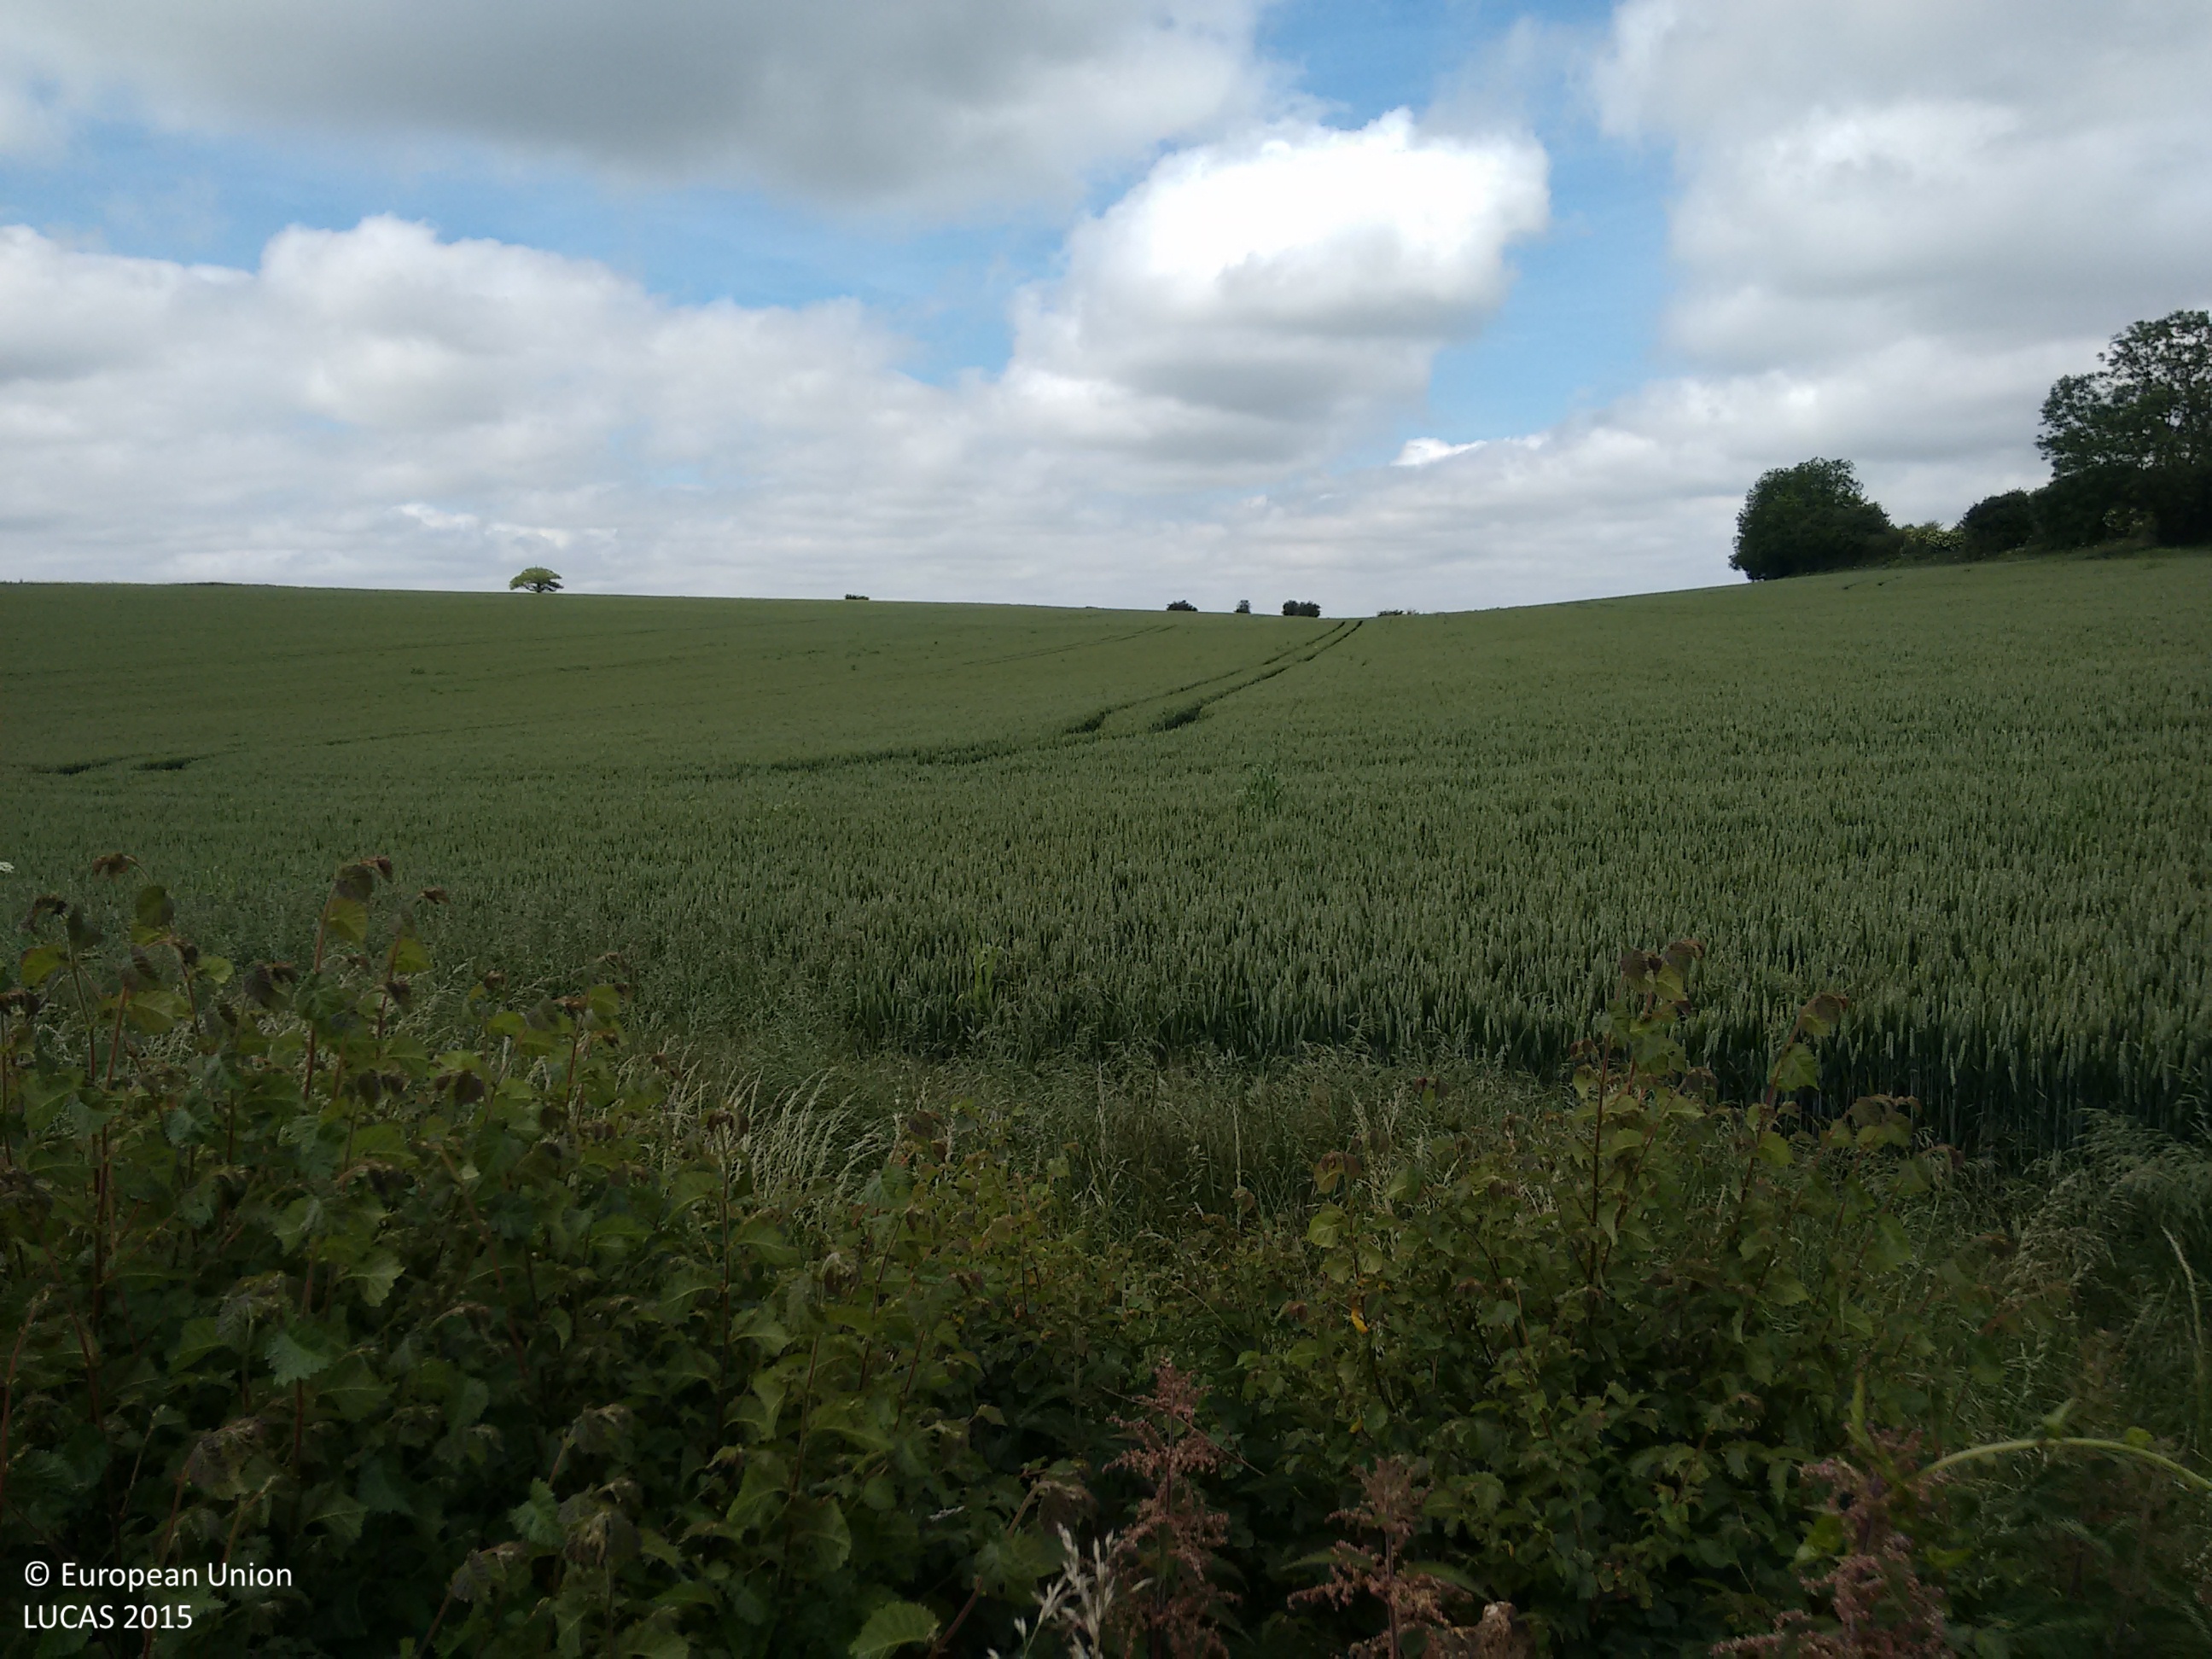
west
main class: Cropland
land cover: Common wheat
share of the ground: > 75 %
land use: Agriculture (excluding fallow land and kitchen gardens)
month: June
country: GB
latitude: 51.0413
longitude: -2.4887
